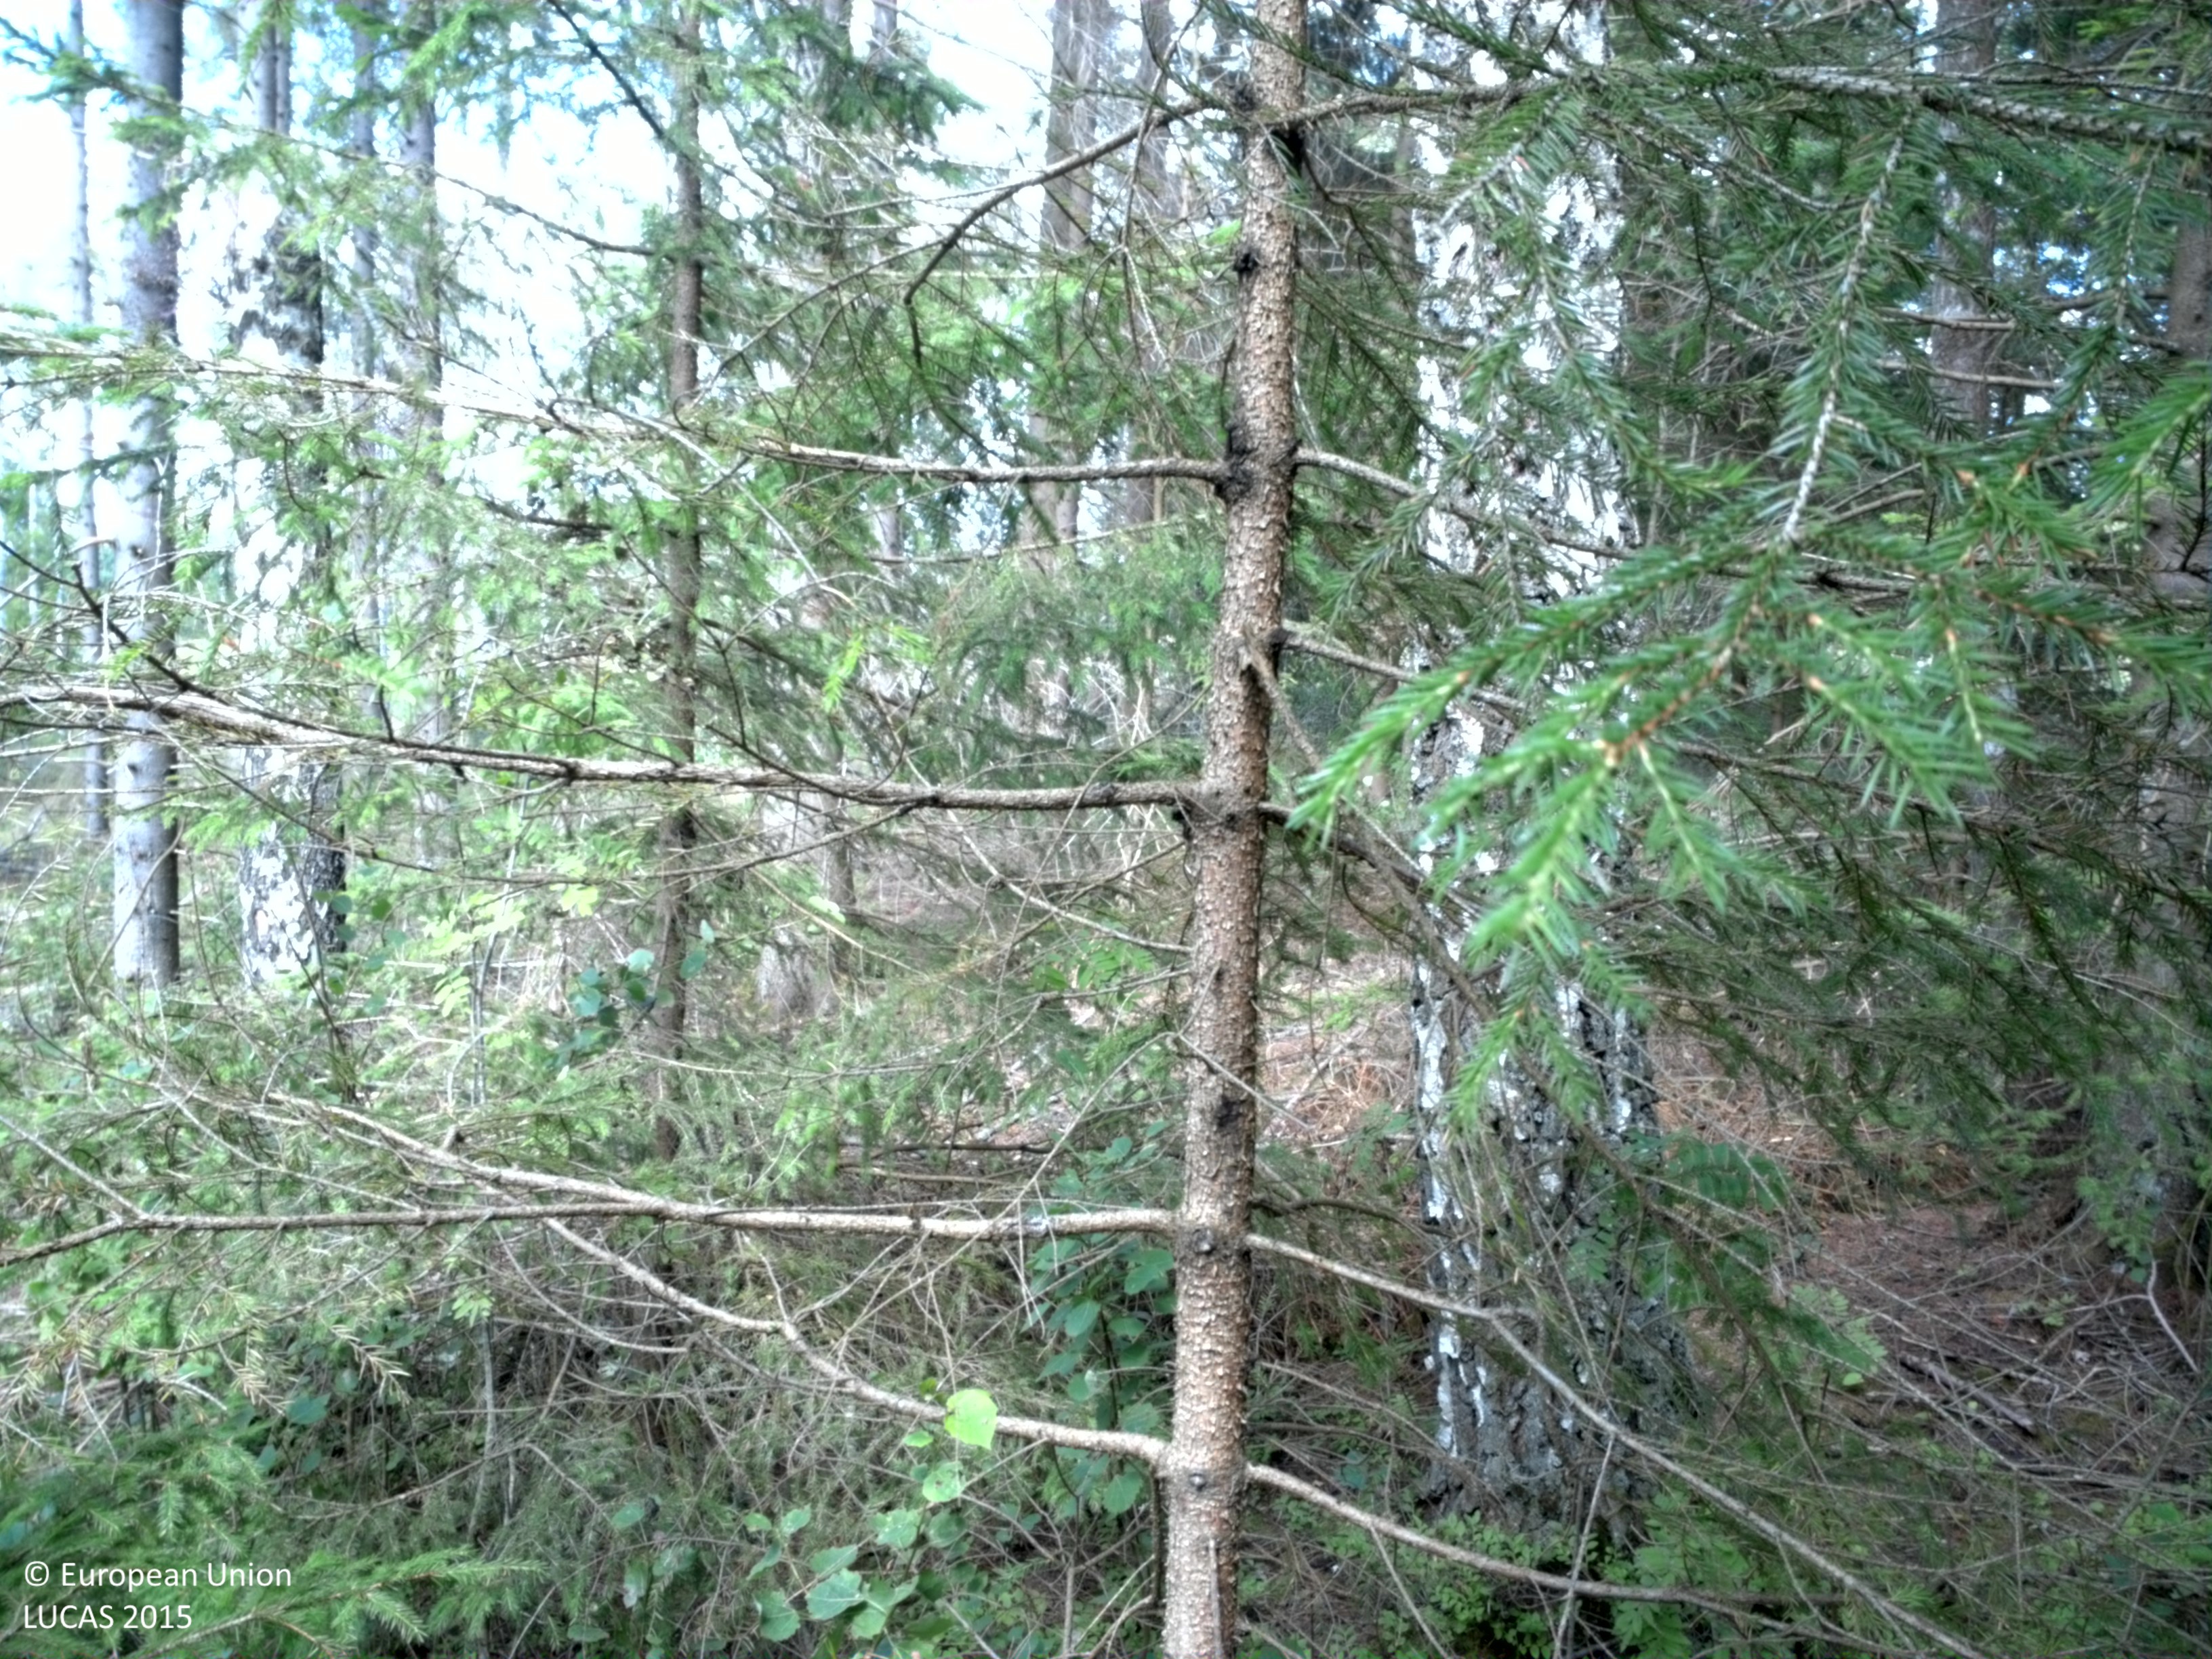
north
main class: Woodland
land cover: Spruce dominated mixed woodland
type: boreal forest
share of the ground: 50 - 75 %
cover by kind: broadleaved forest trees 35 %, coniferous forest trees 30 %, shrubs 15 %, herbaceous plants 10 %, lichens and mosses 10 %
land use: Forestry
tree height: > 5 m
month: July
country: SE
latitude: 58.1813
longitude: 13.8885
